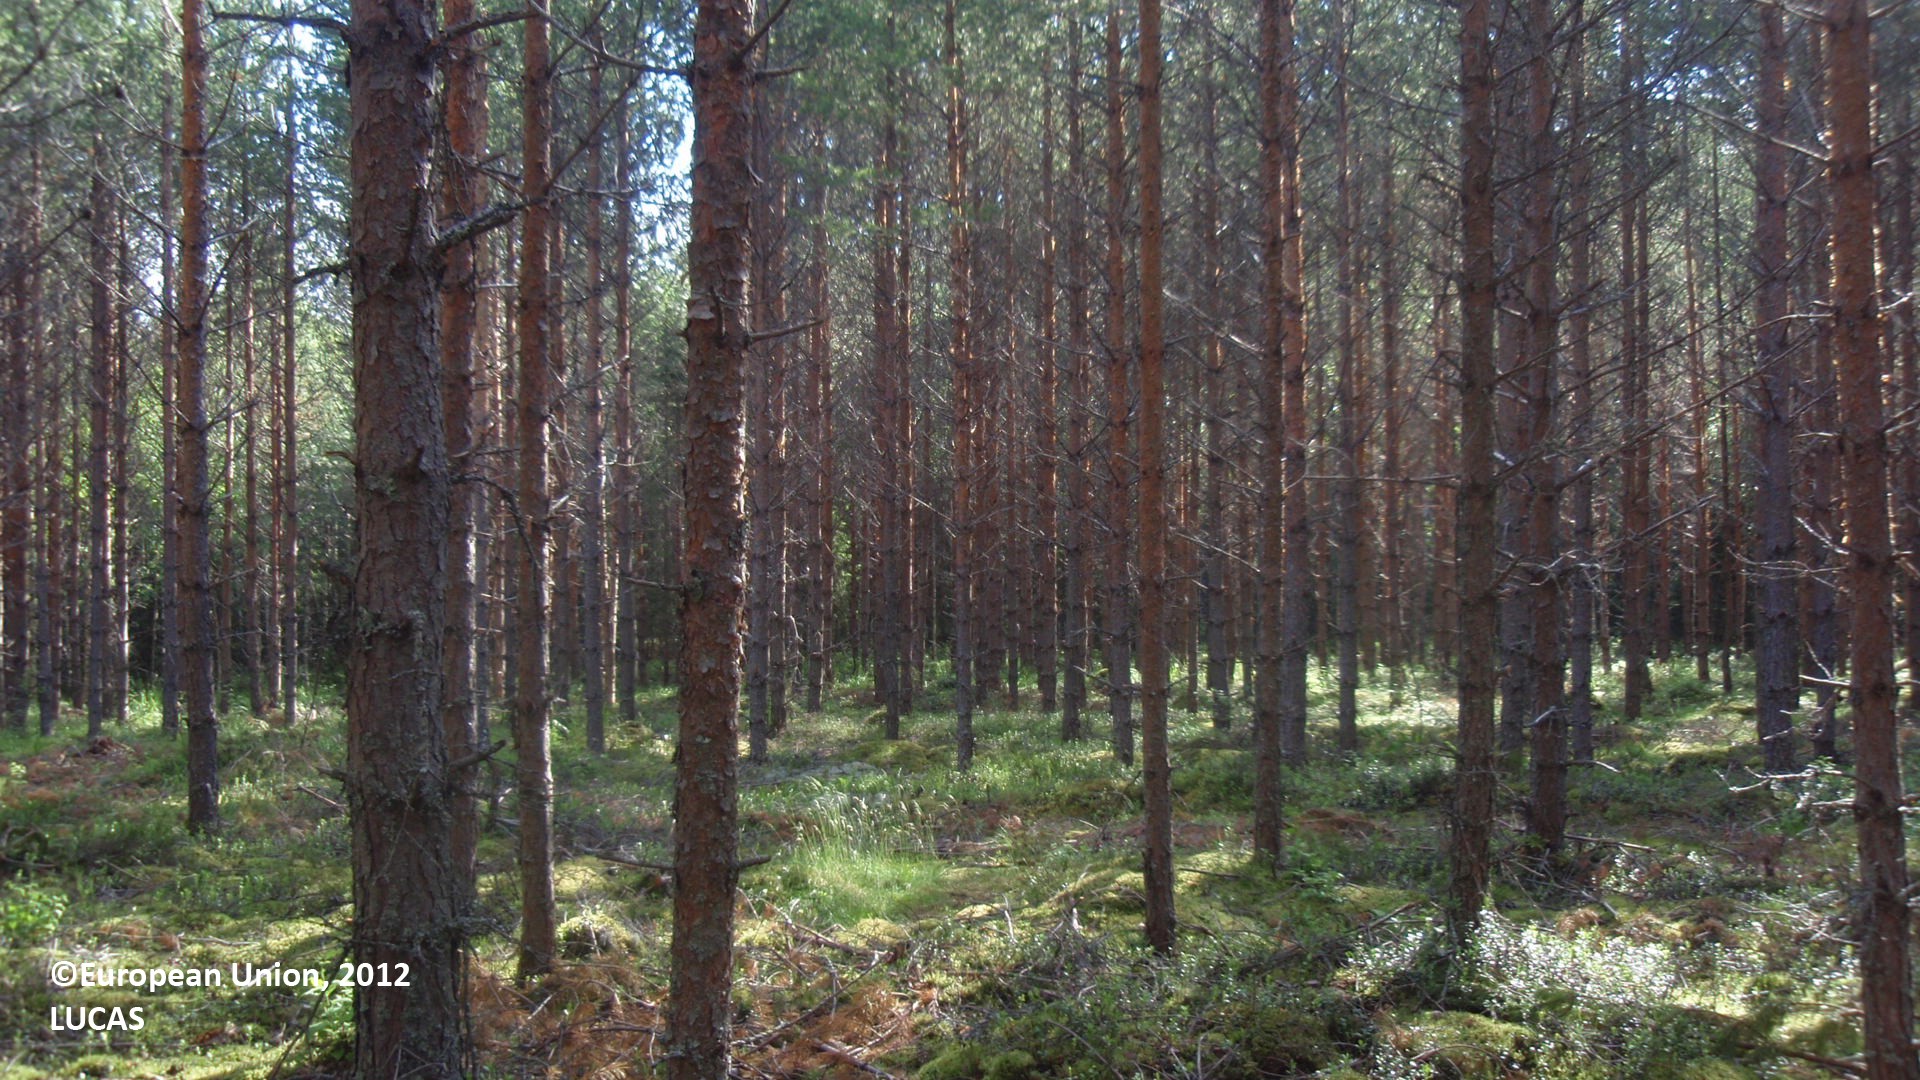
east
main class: Woodland
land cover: Pine dominated coniferous woodland
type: boreal forest
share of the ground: 50 - 75 %
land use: Forestry
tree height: > 5 m
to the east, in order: Pine dominated coniferous woodland; Tracks; Pine dominated coniferous woodland; Other mixed woodland; Ditches and canals; Other mixed woodland; Spruce dominated coniferous woodland; Ditches and canals; Spruce dominated coniferous woodland; Ditches and canals; Spruce dominated coniferous woodland
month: July
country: FI
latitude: 61.7766
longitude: 28.2649
